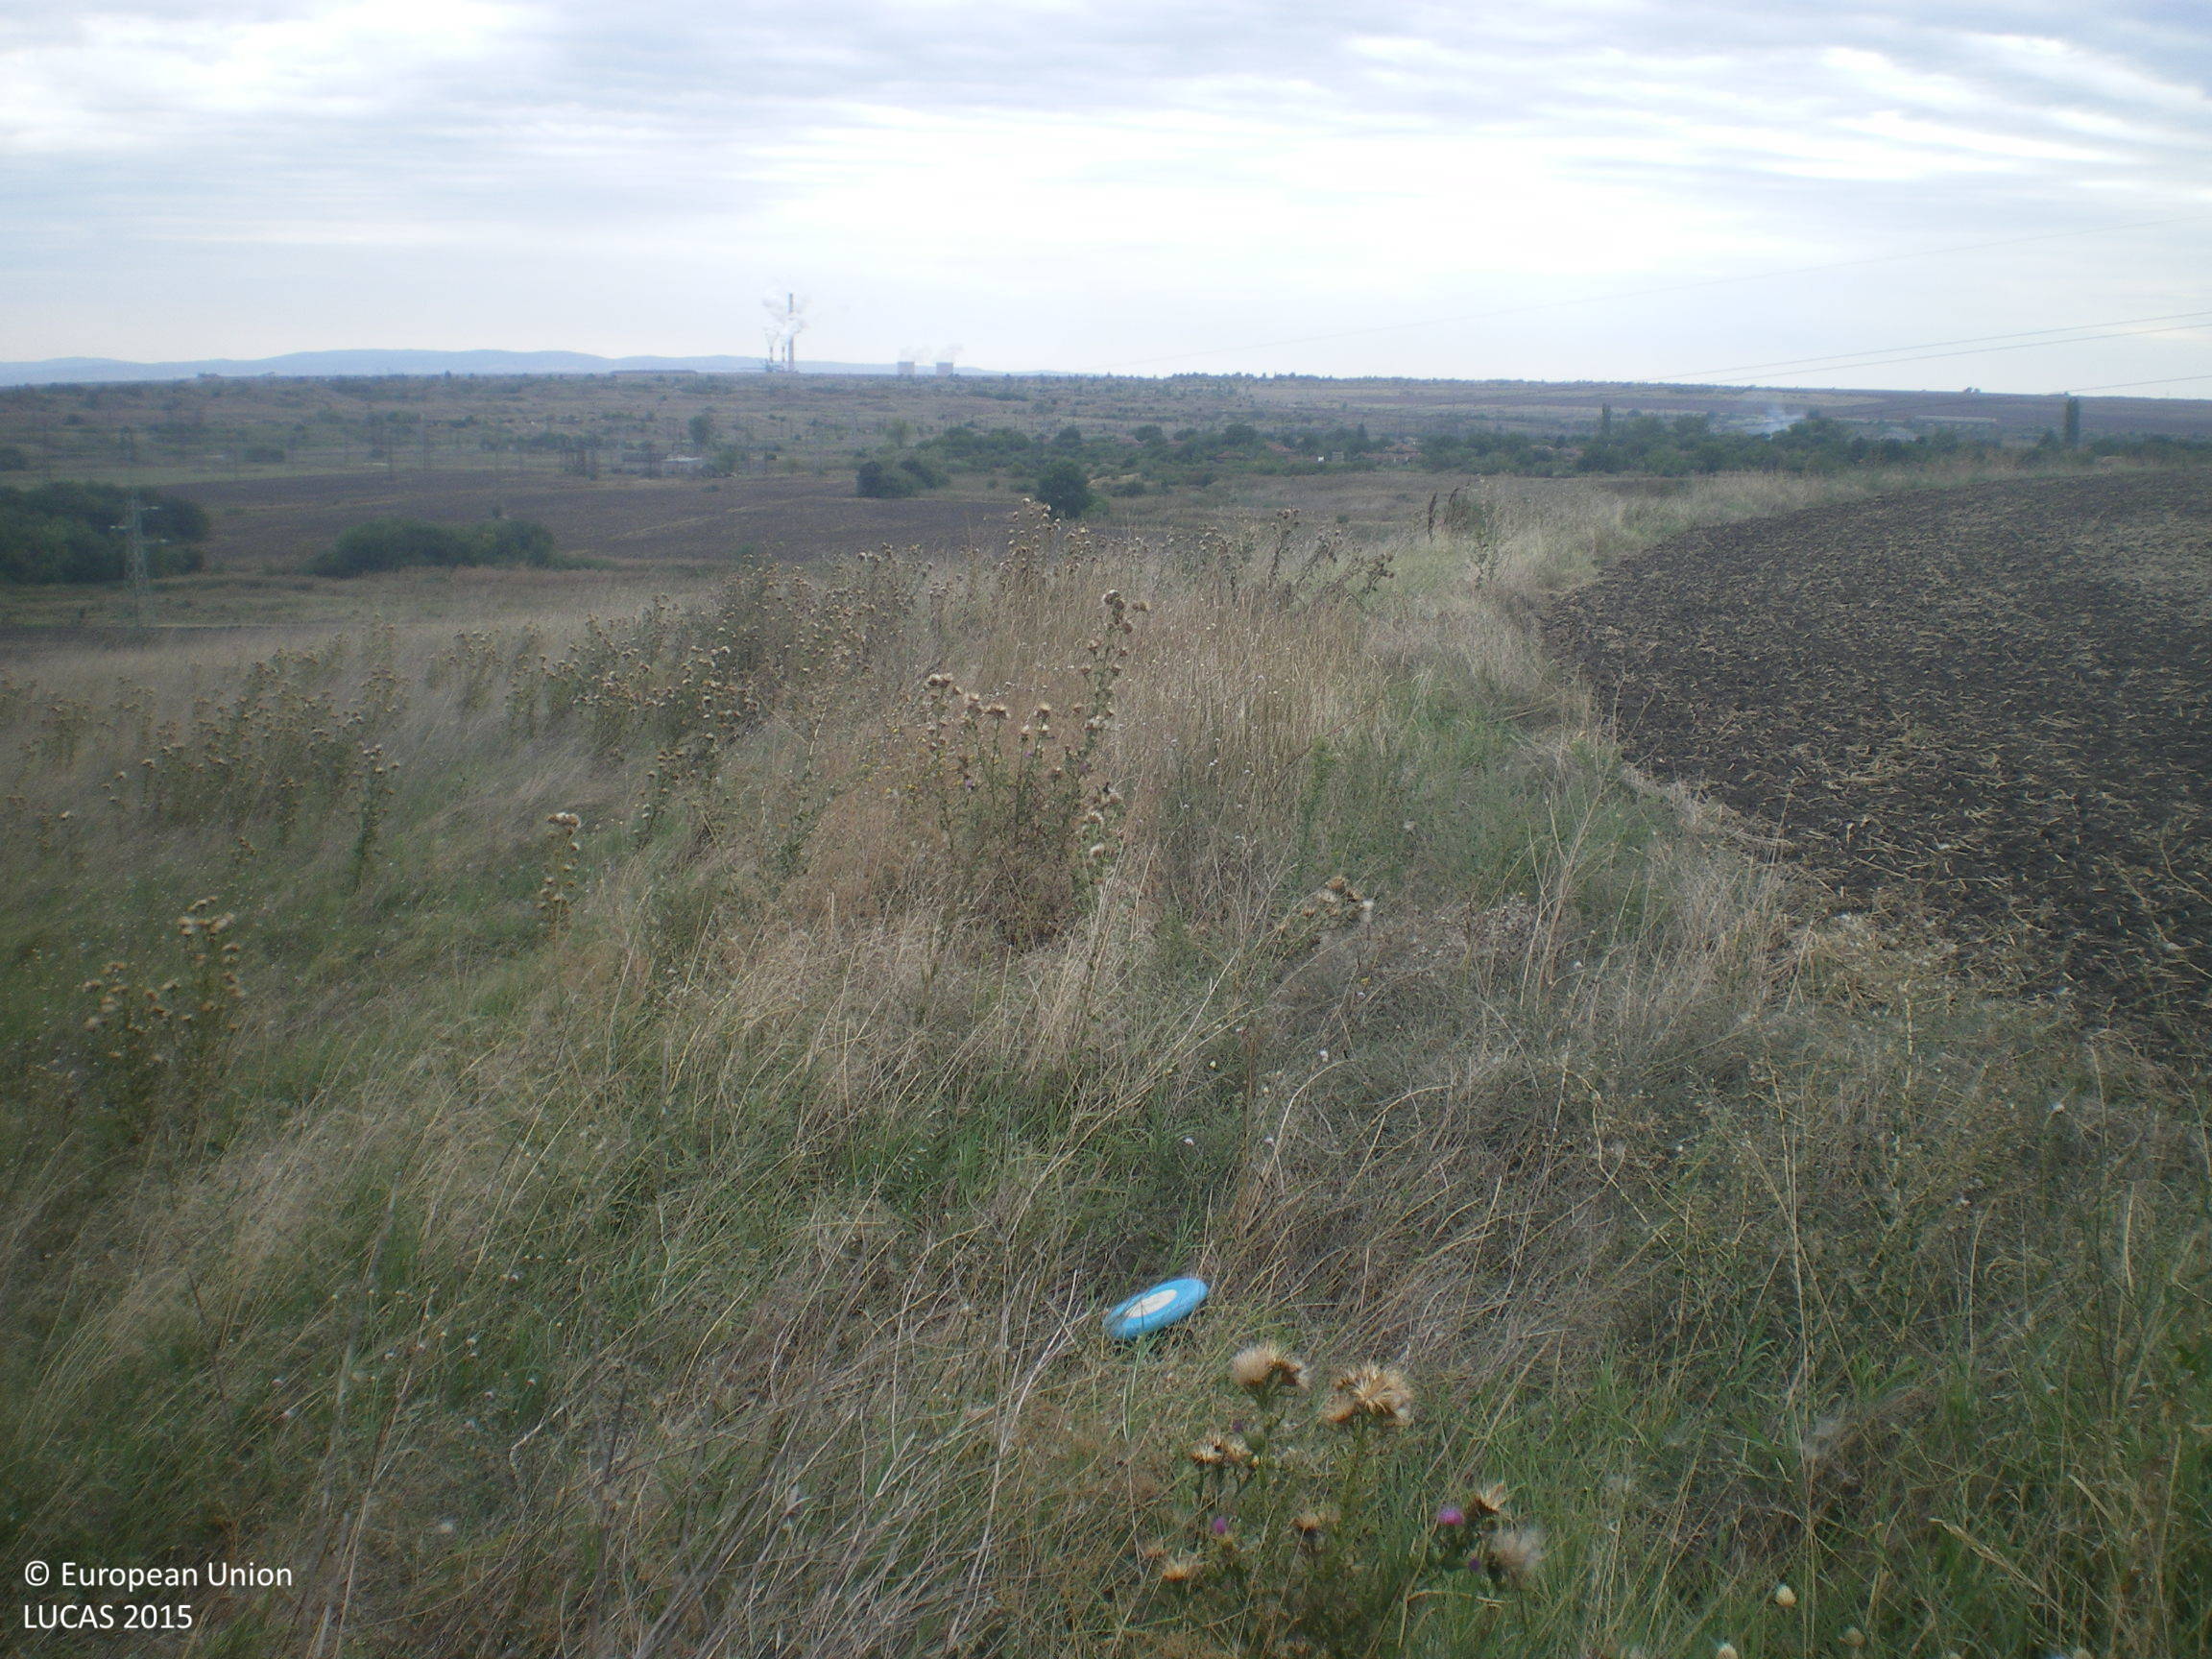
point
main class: Grassland
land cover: Grassland without tree/shrub cover
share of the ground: > 75 %
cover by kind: herbaceous plants 100 %
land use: Agriculture (excluding fallow land and kitchen gardens)
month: September
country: BG
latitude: 42.2066
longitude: 25.9550
